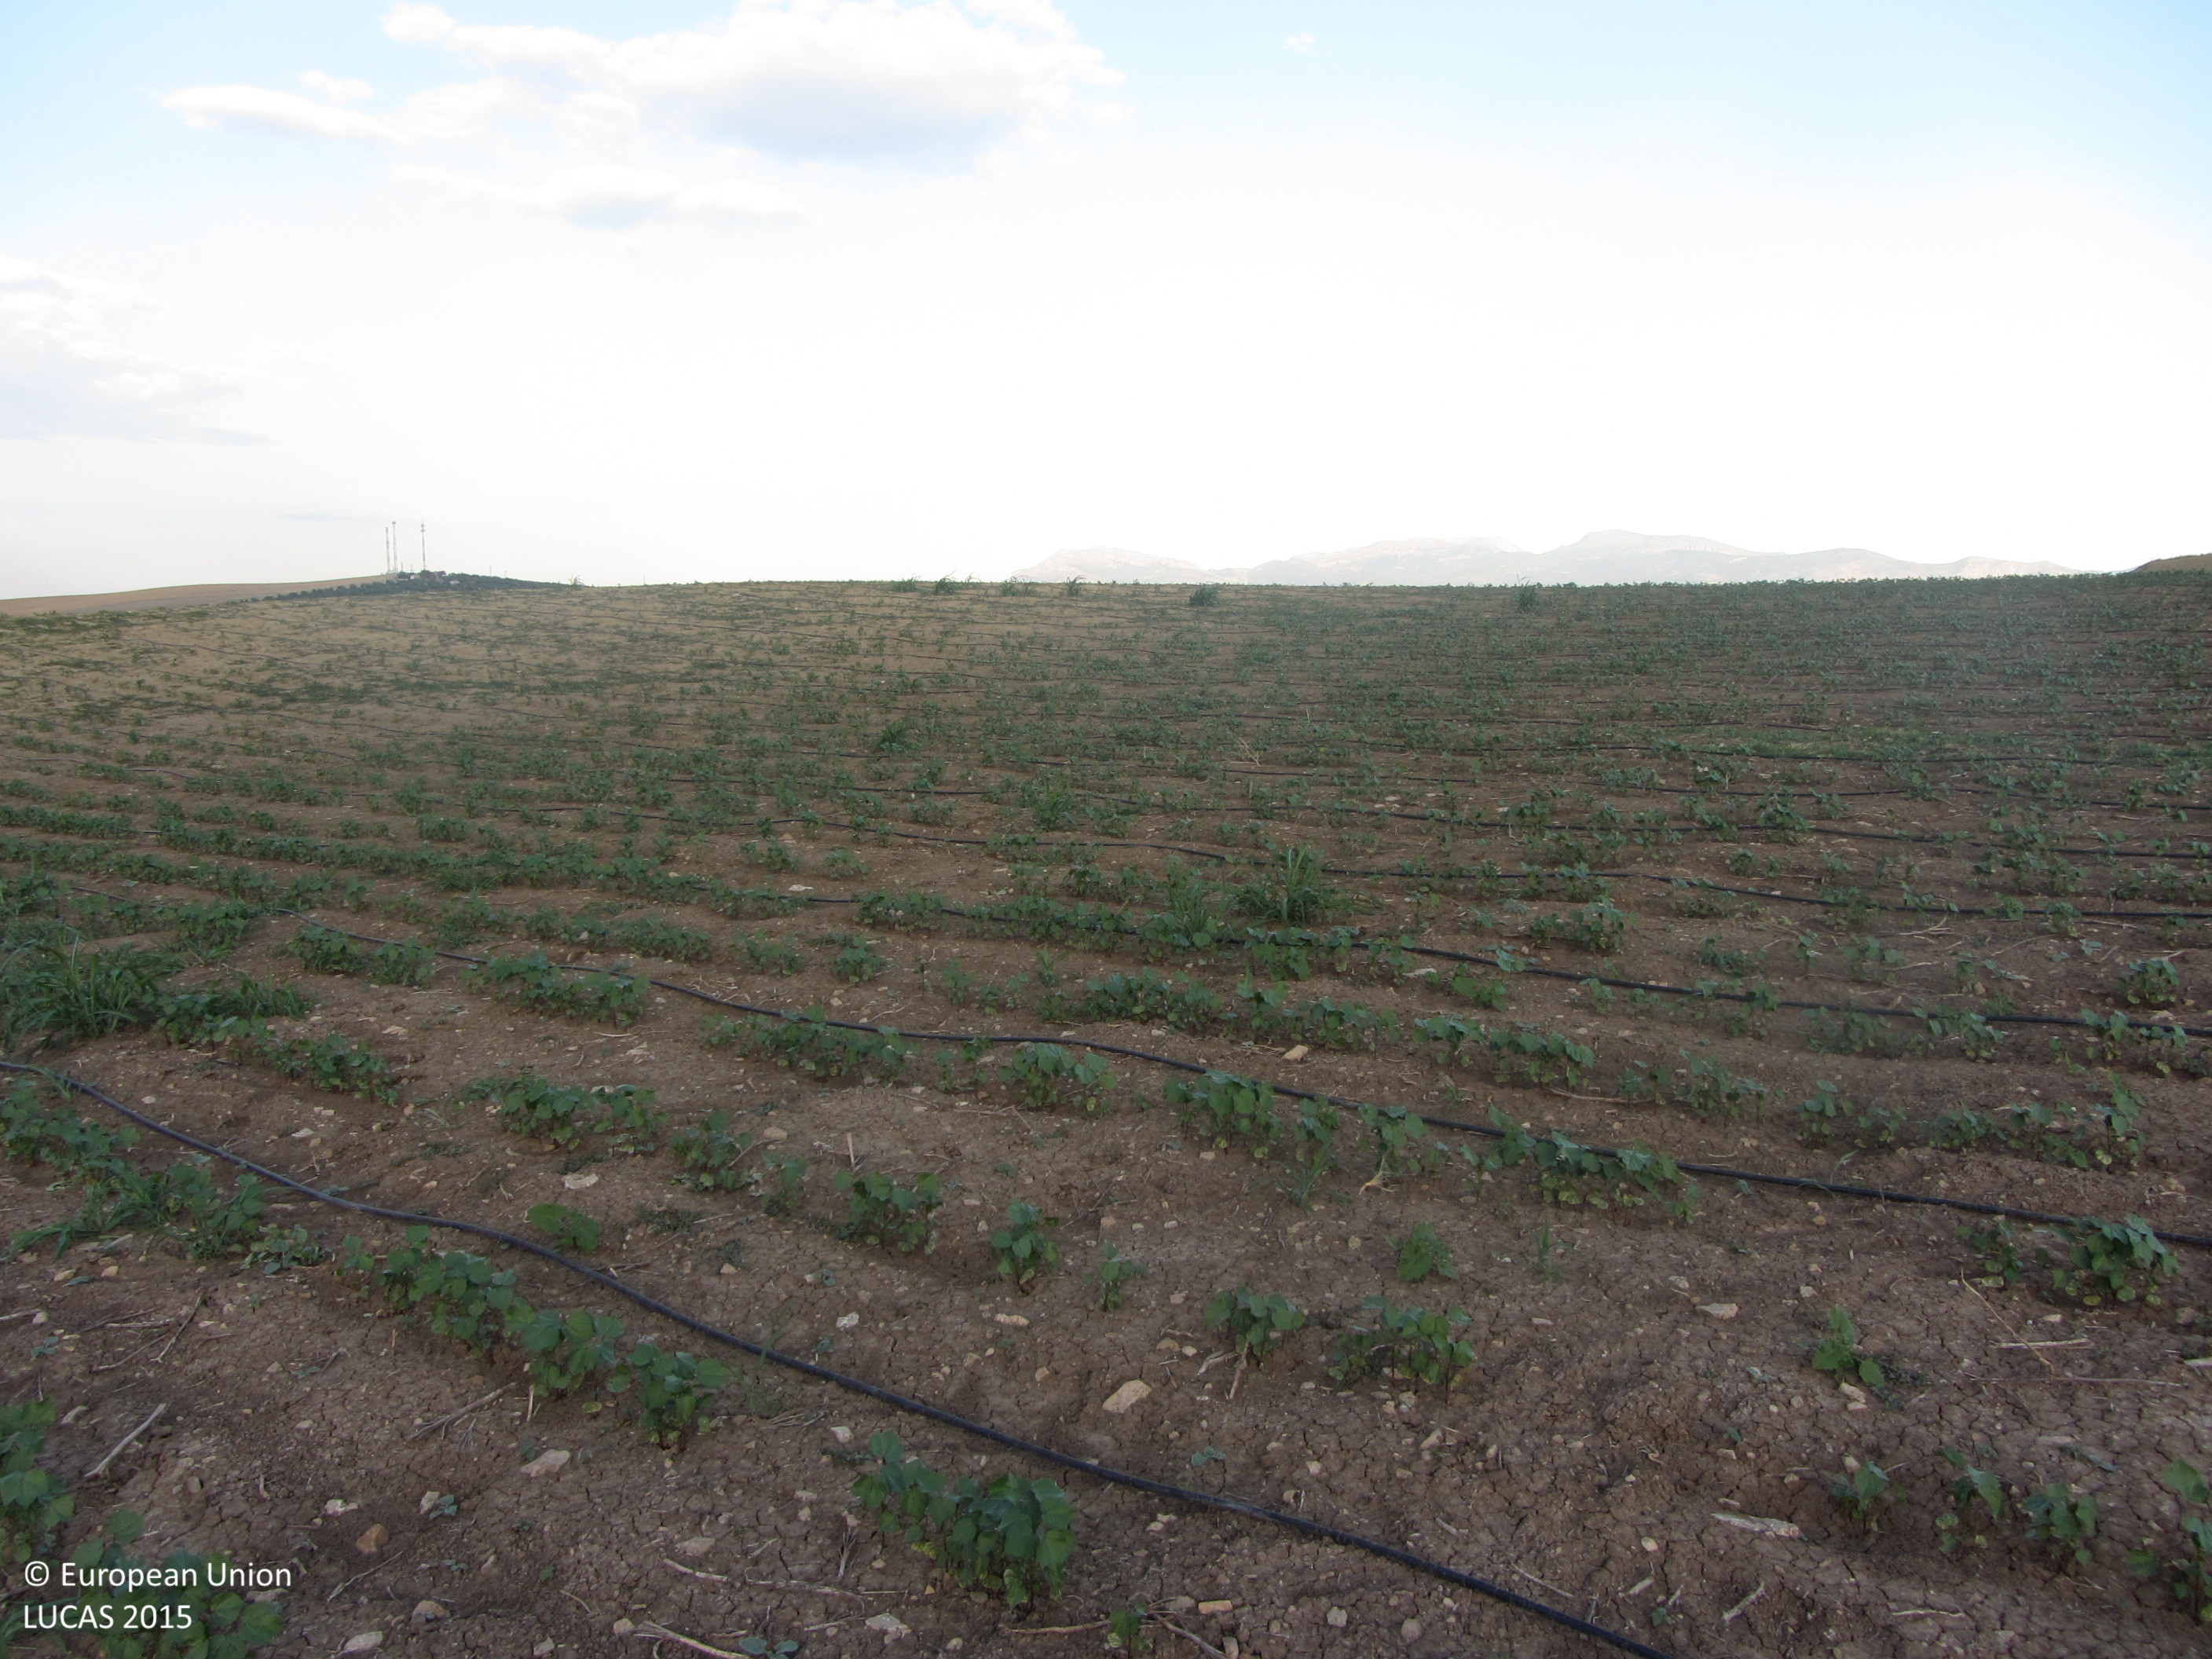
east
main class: Cropland
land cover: Cotton
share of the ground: < 10 %
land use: Agriculture (excluding fallow land and kitchen gardens)
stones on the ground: < 10 %
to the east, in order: Cotton
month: June
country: ES
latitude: 37.9292
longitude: -3.8036
